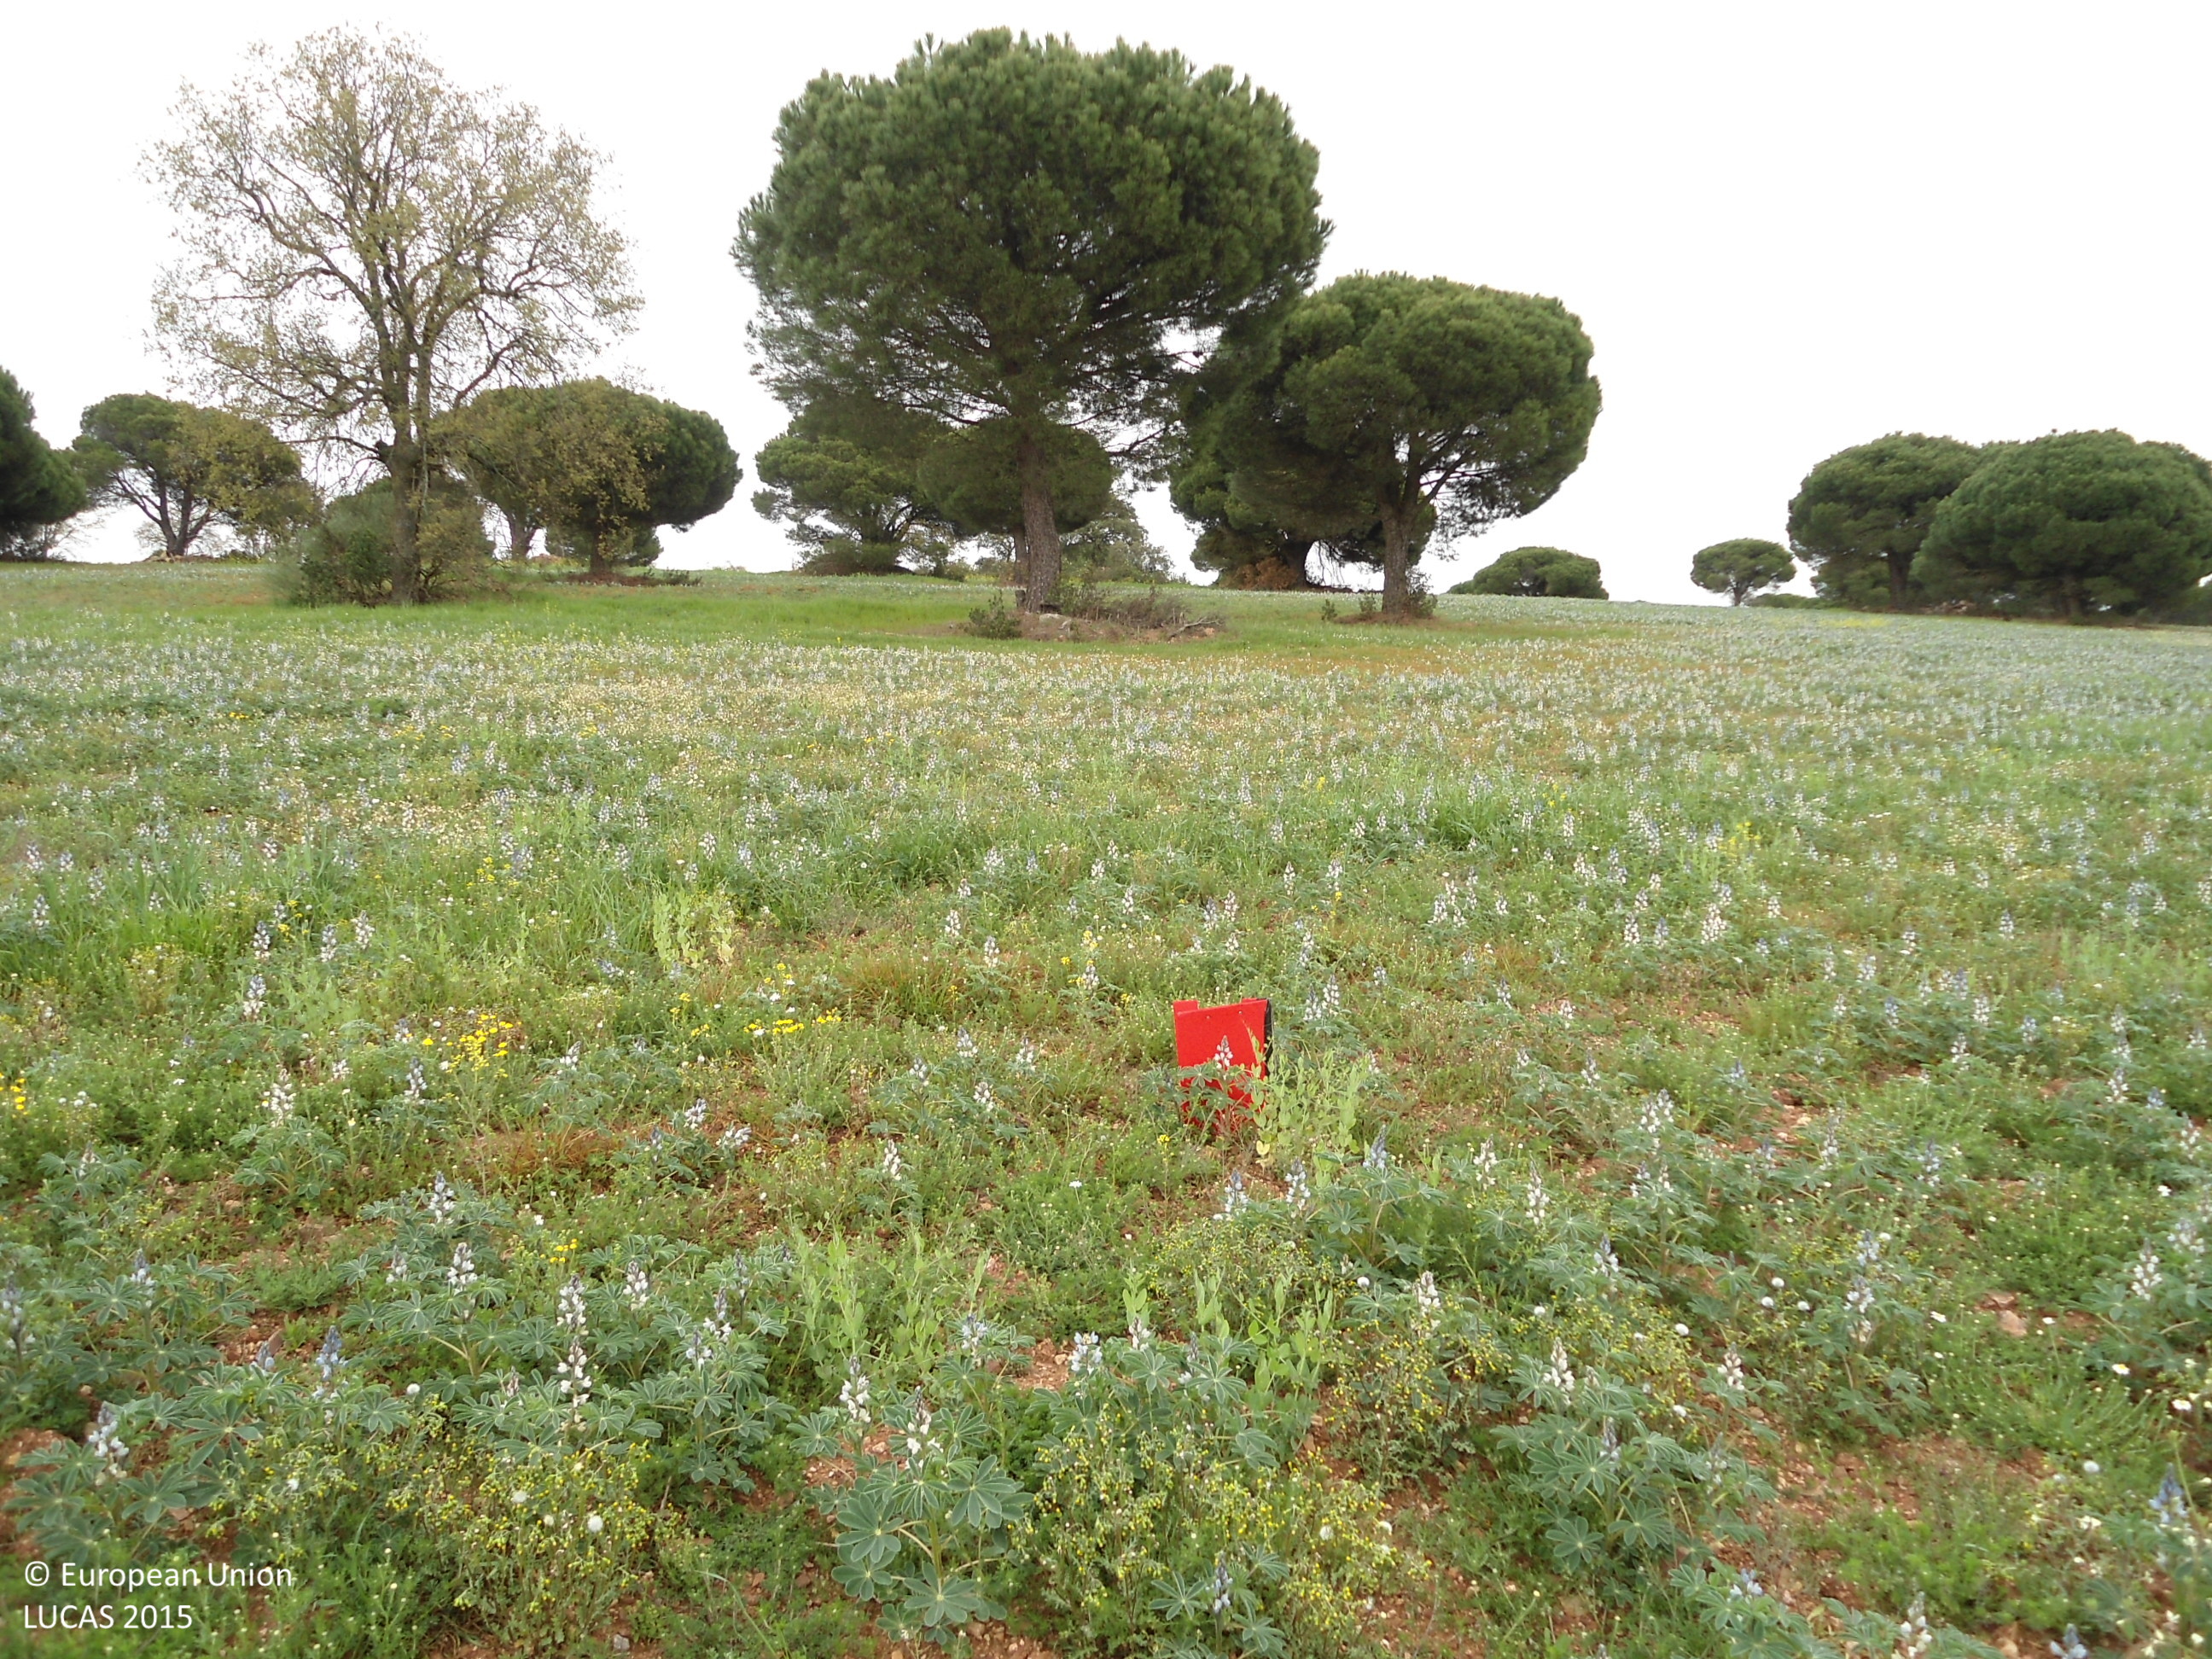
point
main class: Cropland
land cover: Dry pulses
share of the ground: > 75 %
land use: Agriculture (excluding fallow land and kitchen gardens)
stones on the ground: 10 - 25 %
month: April
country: ES
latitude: 41.5609
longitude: -5.8573
